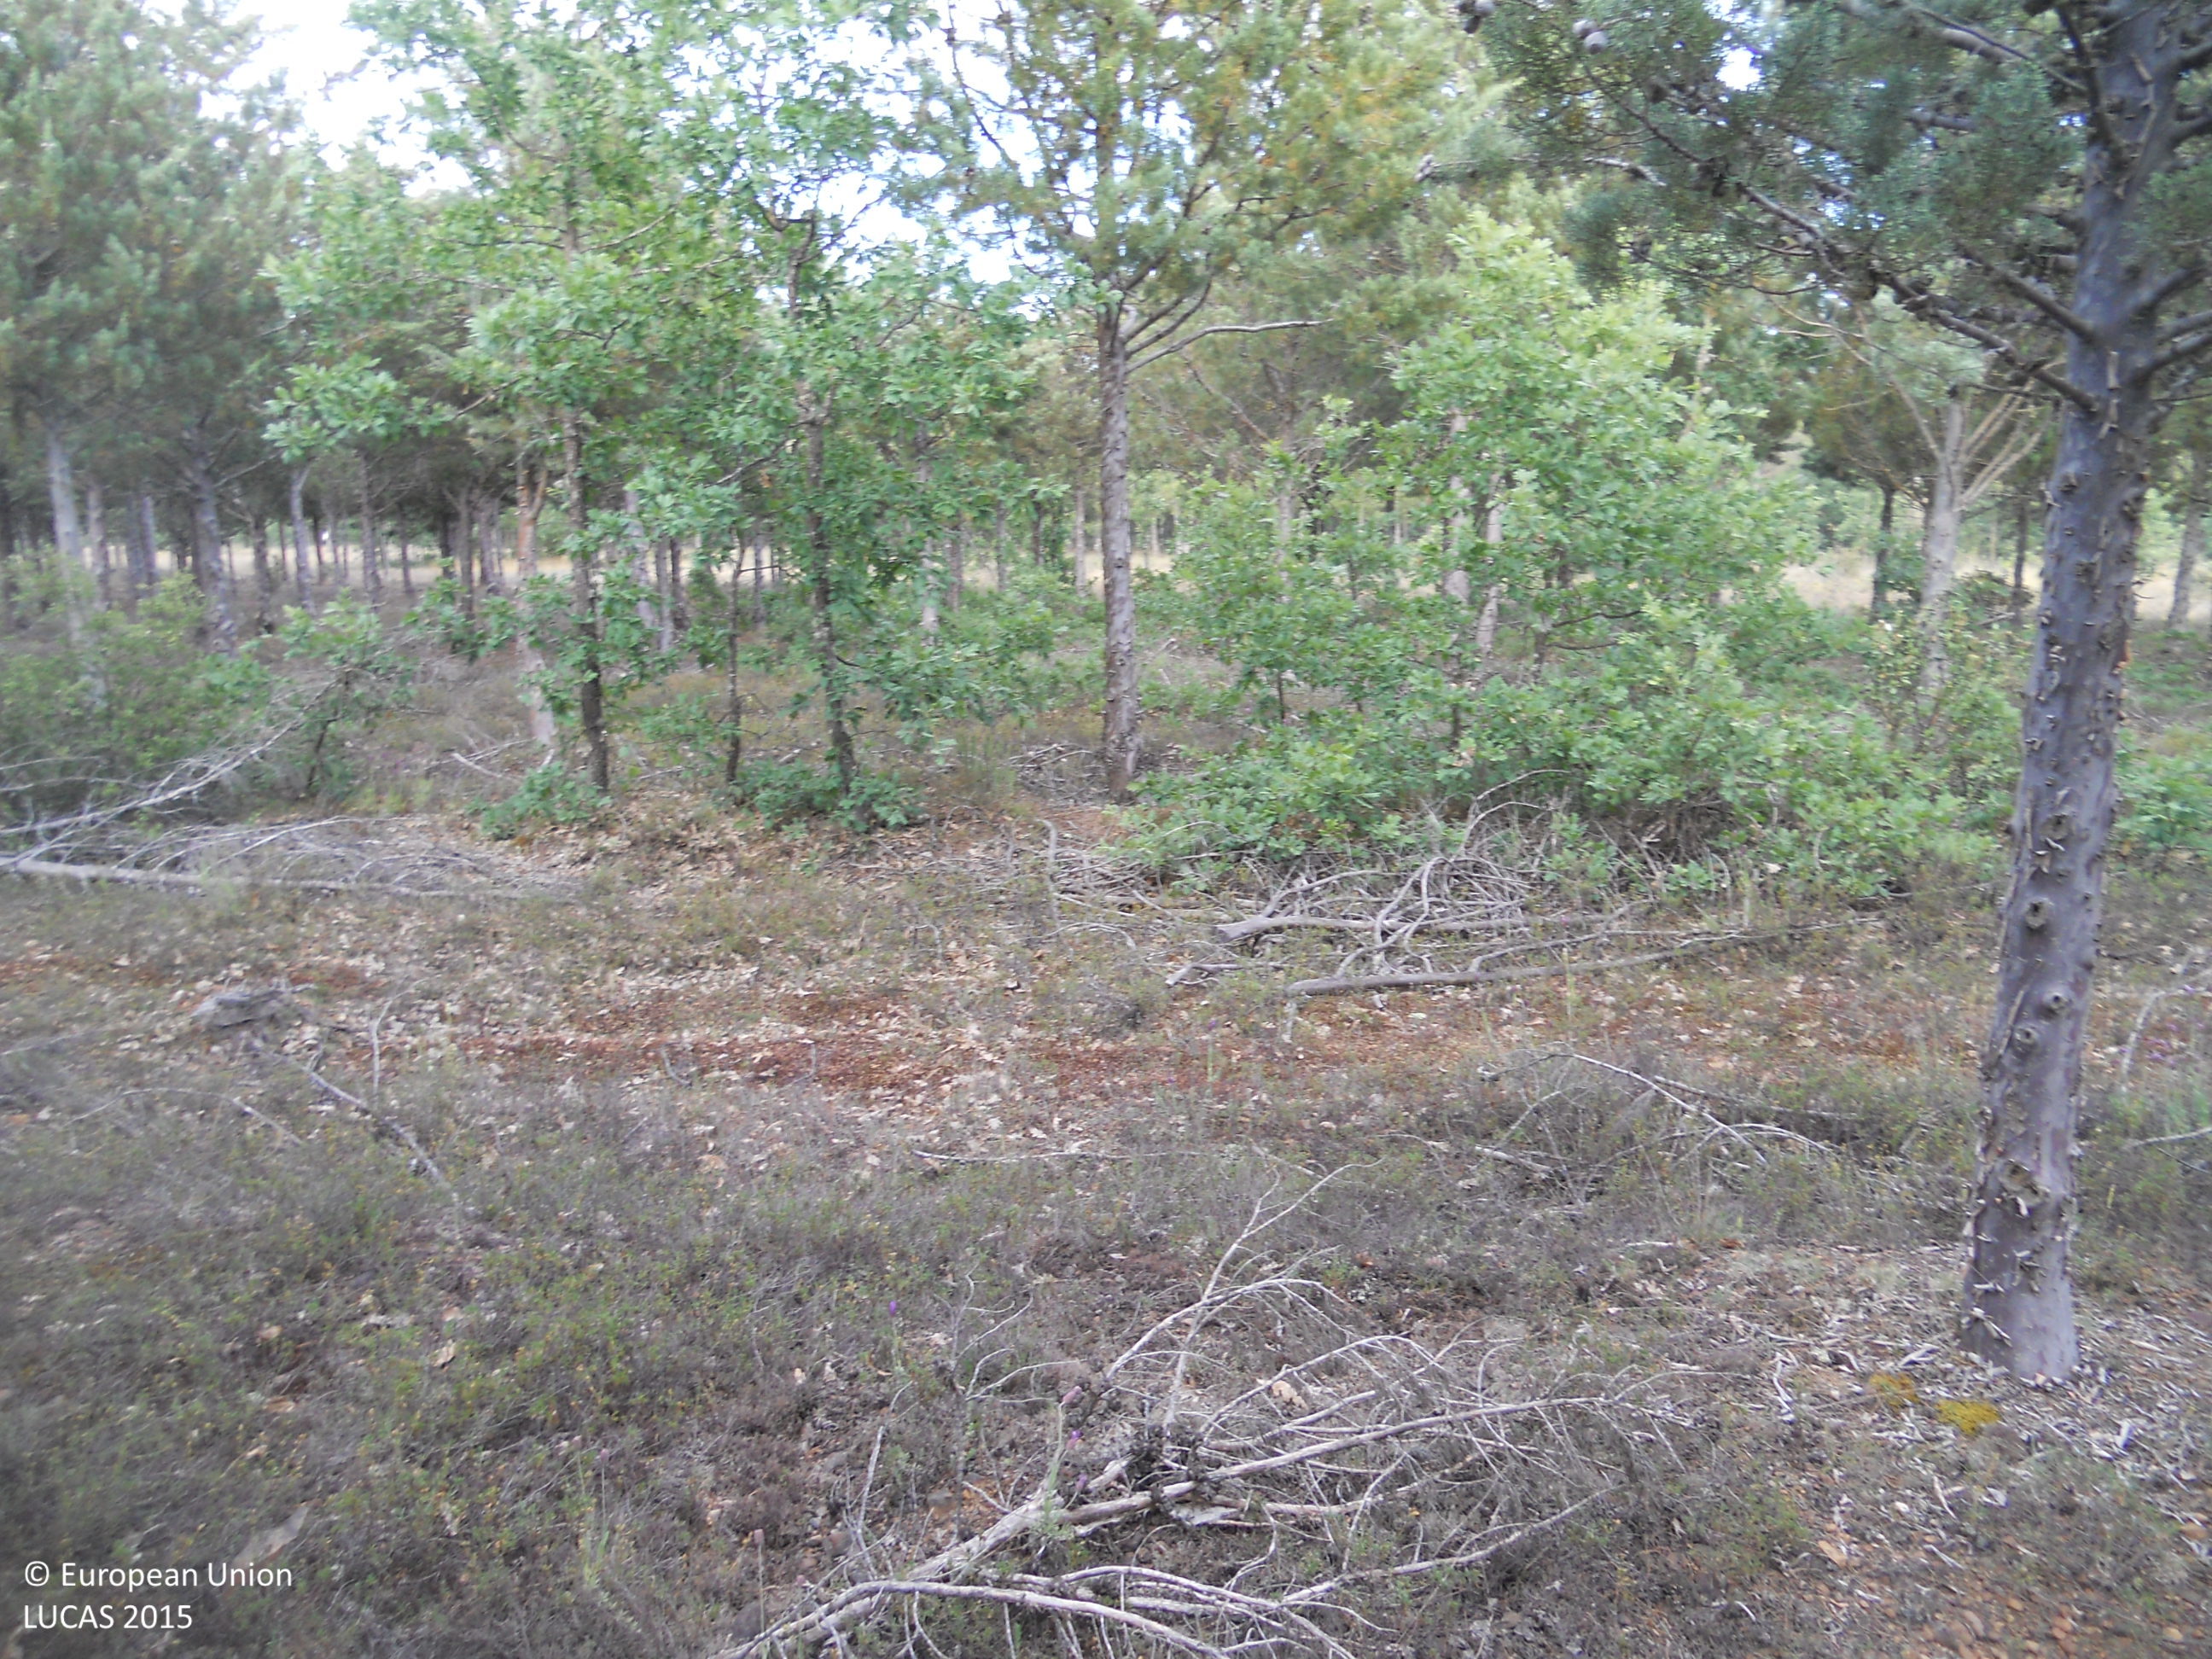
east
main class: Woodland
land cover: Other mixed woodland
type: acidophilous oak and oak-birch forest
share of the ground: > 75 %
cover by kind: broadleaved forest trees 35 %, herbaceous plants 20 %, coniferous forest trees 15 %, shrubs 5 %, unconsolidated bare surface 5 %
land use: Forestry
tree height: < 5 m
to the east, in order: Other mixed woodland; Grassland with sparse tree/shrub cover; Tracks; Grassland without tree/shrub cover; Other coniferous woodland; Pine dominated mixed woodland
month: June
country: ES
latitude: 42.3616
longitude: -4.8320
